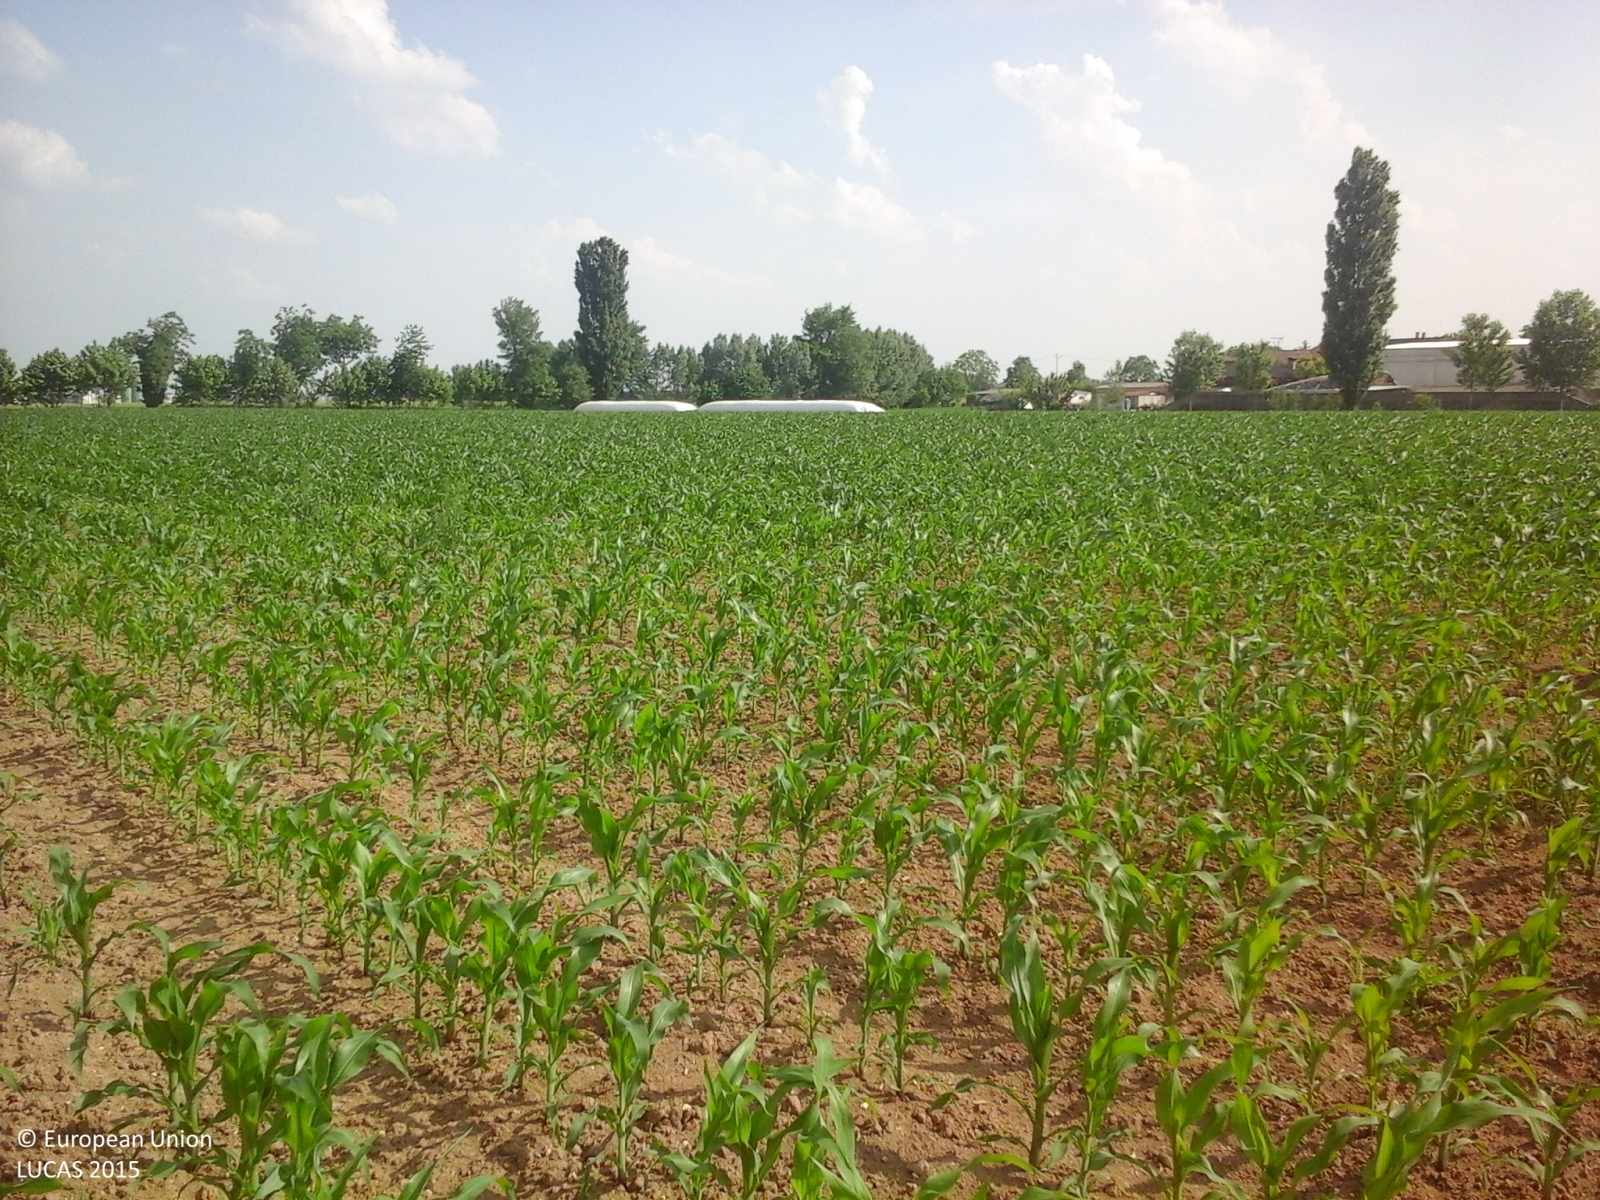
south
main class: Cropland
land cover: Maize
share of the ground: 25 - 50 %
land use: Agriculture (excluding fallow land and kitchen gardens)
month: May
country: IT
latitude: 45.2322
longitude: 10.6230
